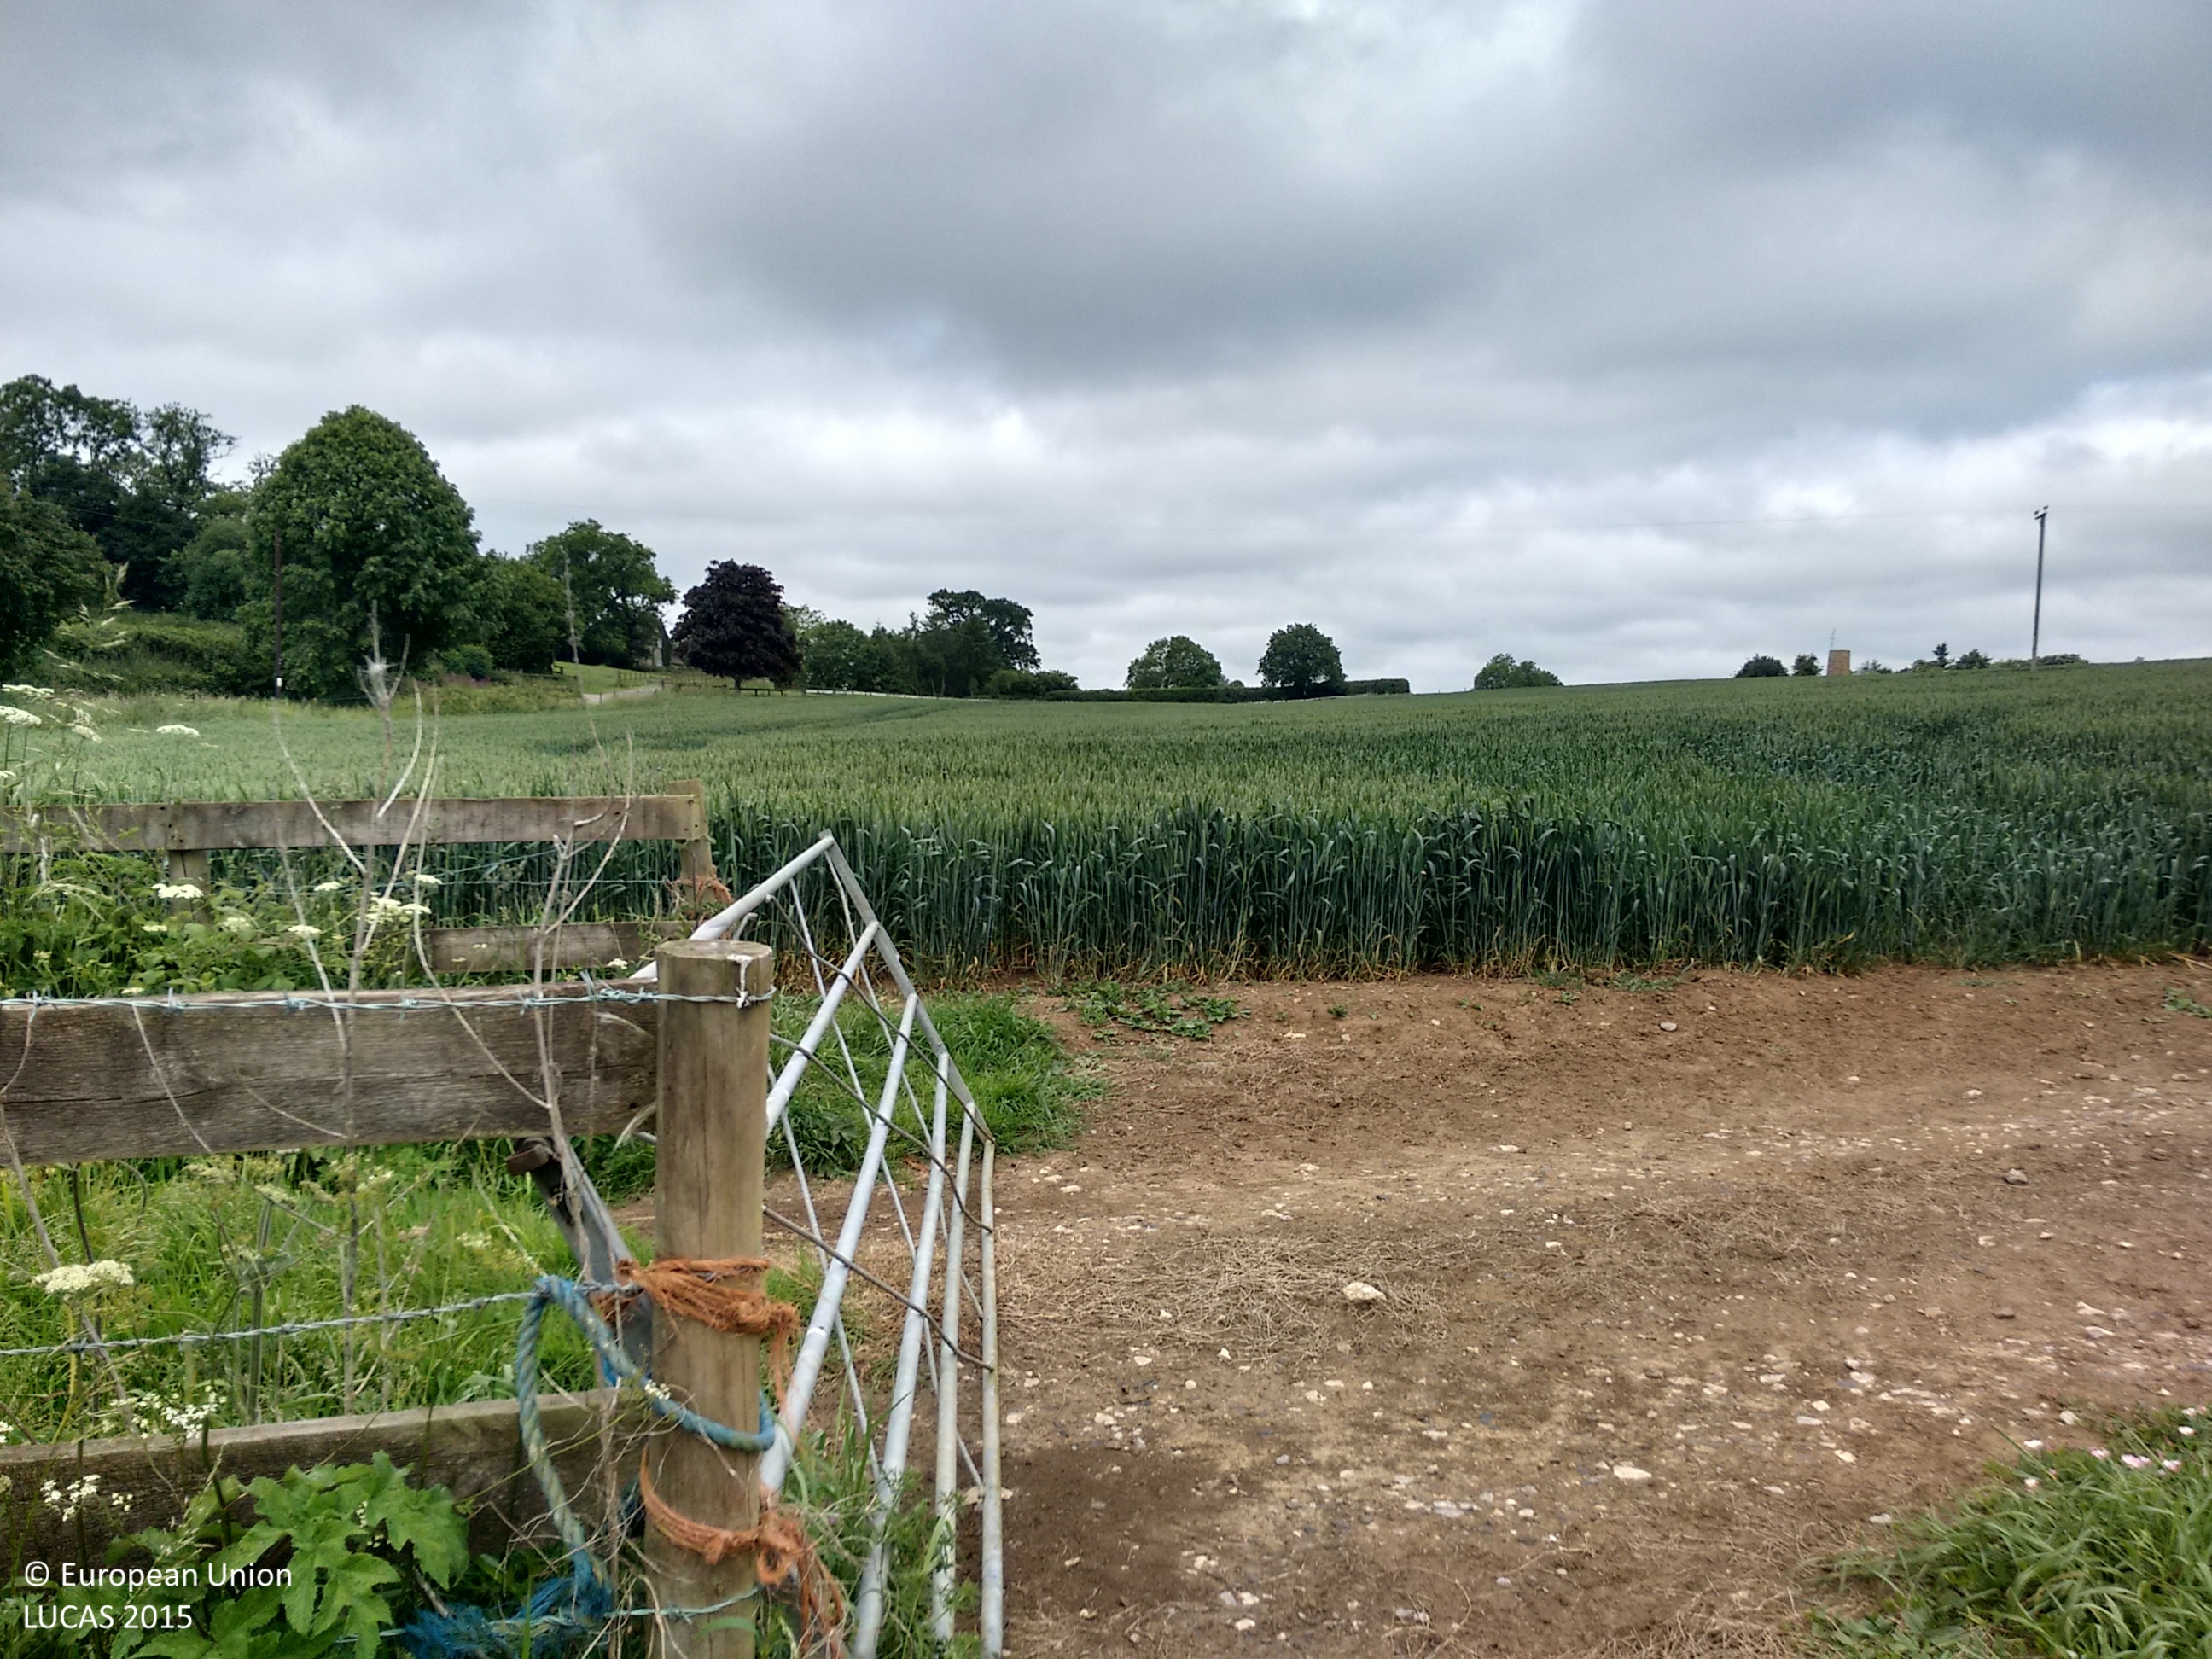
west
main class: Cropland
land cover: Common wheat
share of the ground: > 75 %
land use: Agriculture (excluding fallow land and kitchen gardens)
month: June
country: GB
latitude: 51.0651
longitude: -2.4371
